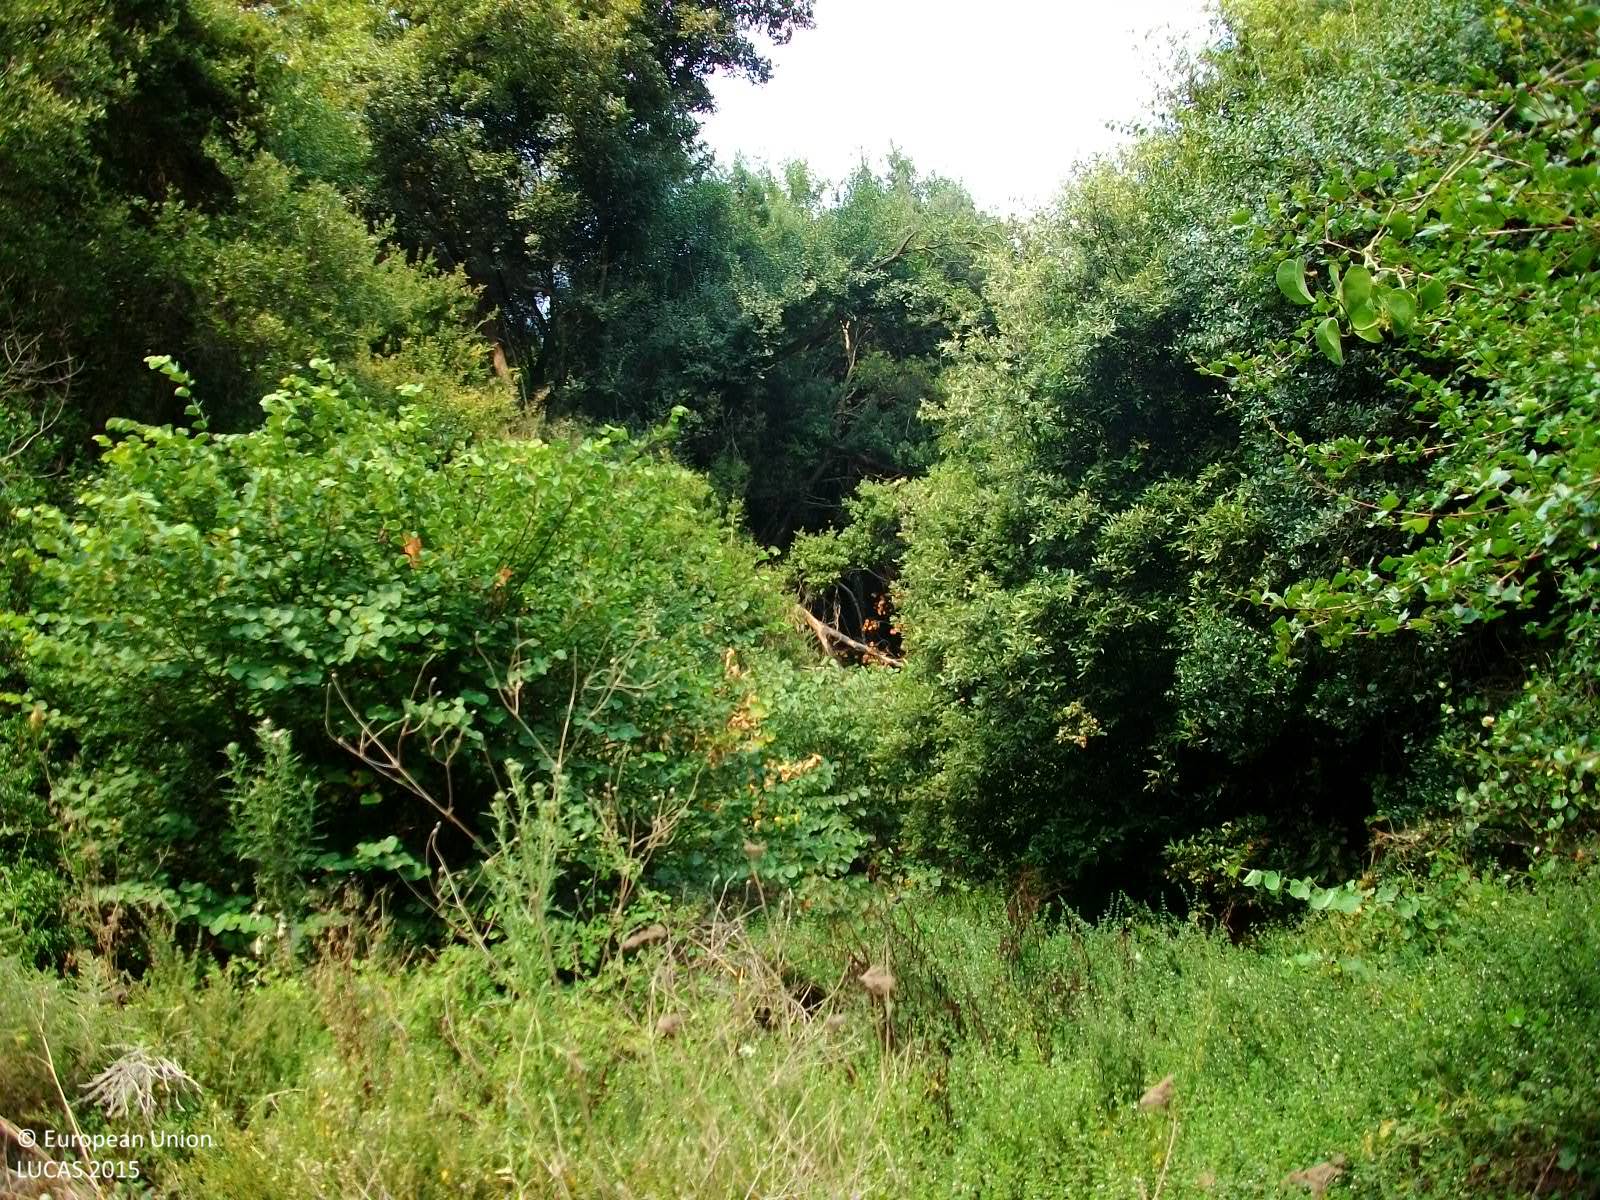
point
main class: Woodland
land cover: Broadleaved woodland
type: broadleaved evergreen forest
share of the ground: > 75 %
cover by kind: broadleaved forest trees 95 %, shrubs 5 %
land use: Semi-natural and natural areas not in use
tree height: > 5 m
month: July
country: GR
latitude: 37.0007
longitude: 21.8744
